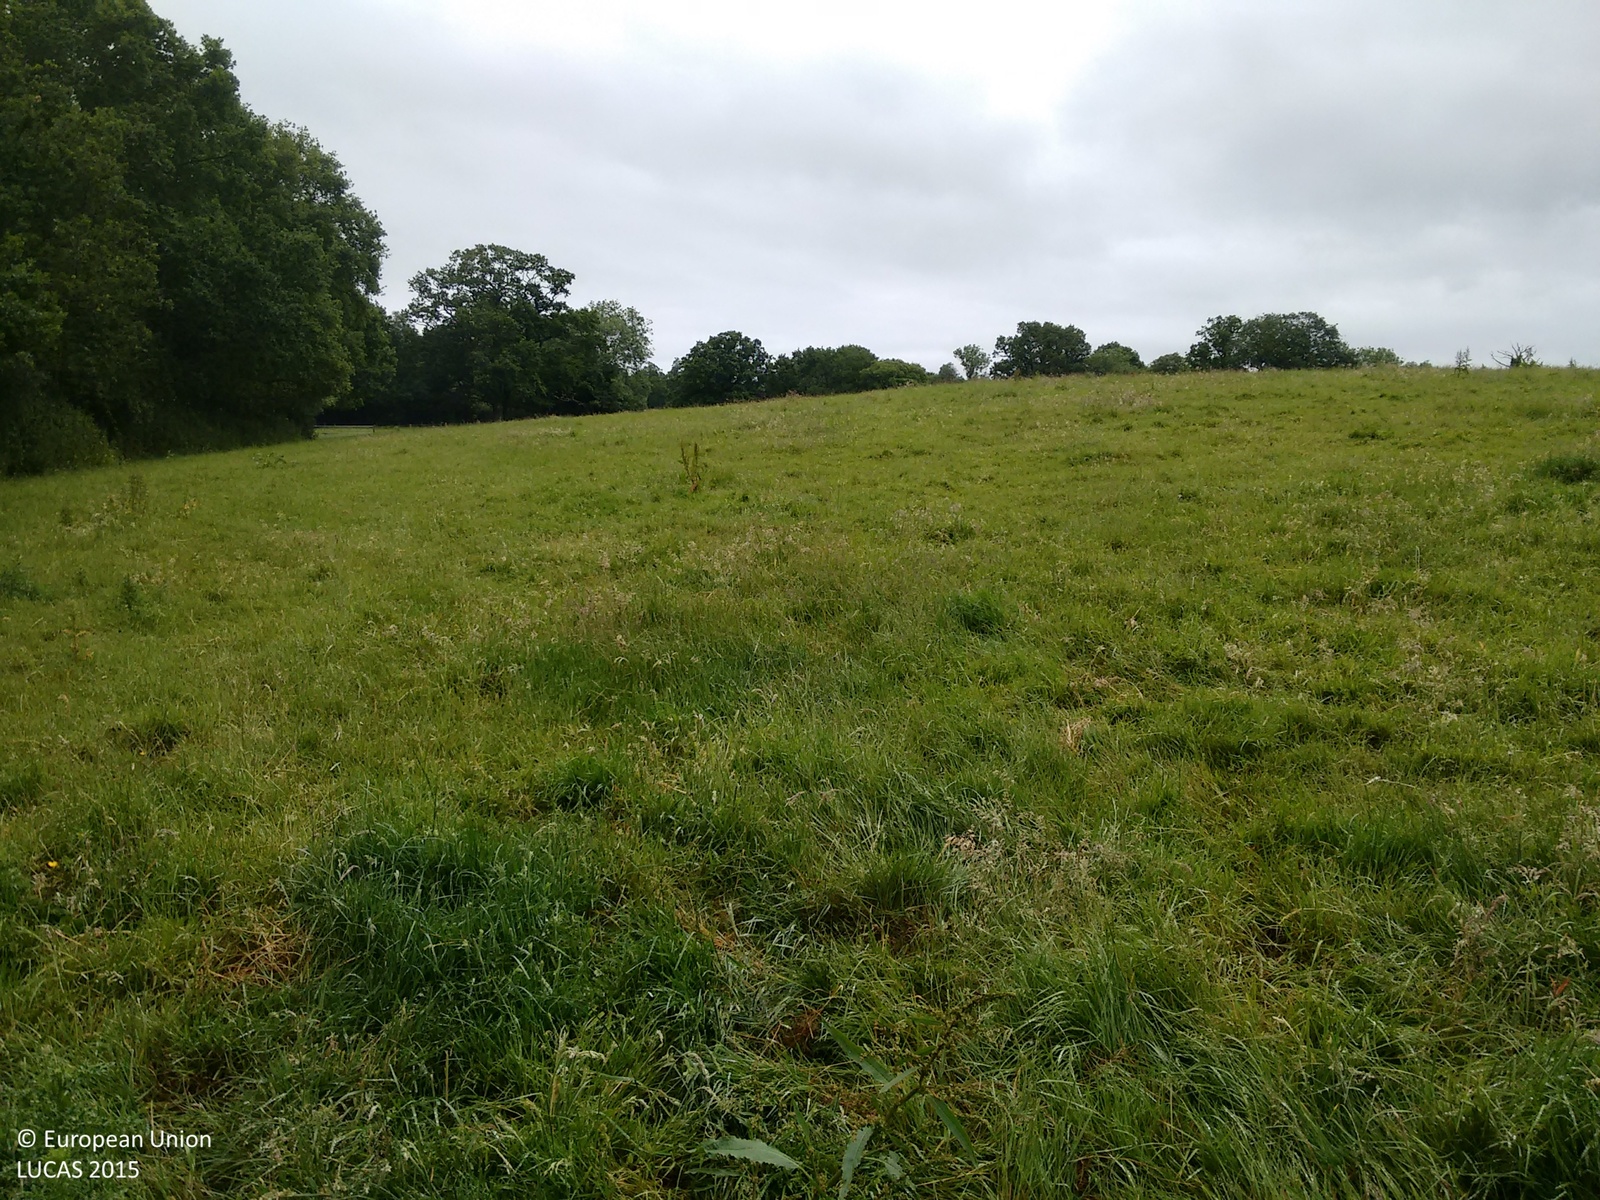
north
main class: Grassland
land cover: Grassland without tree/shrub cover
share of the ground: > 75 %
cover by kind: herbaceous plants 100 %
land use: Agriculture (excluding fallow land and kitchen gardens)
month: June
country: GB
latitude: 50.9902
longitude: 0.3830
